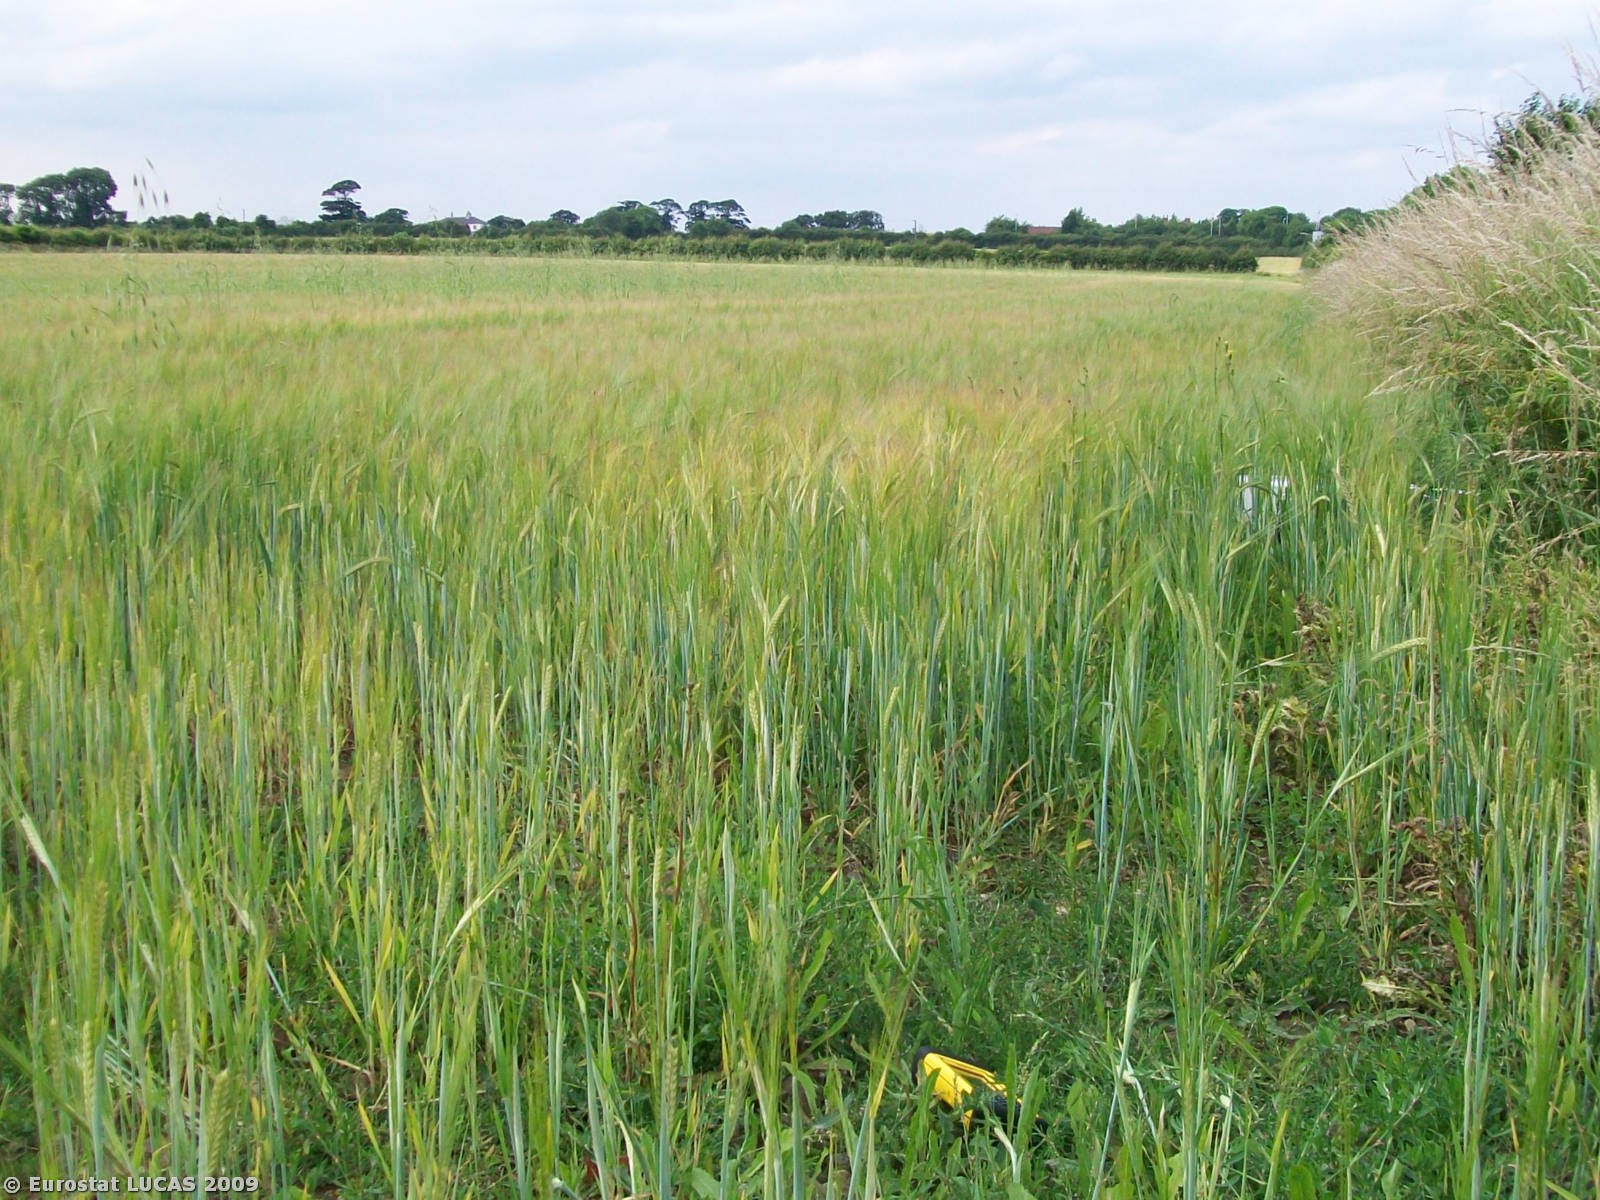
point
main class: Cropland
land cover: Barley
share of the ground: 10 - 25 %
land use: Agriculture (excluding fallow land and kitchen gardens)
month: July
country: GB
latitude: 53.7743
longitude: -1.3520
